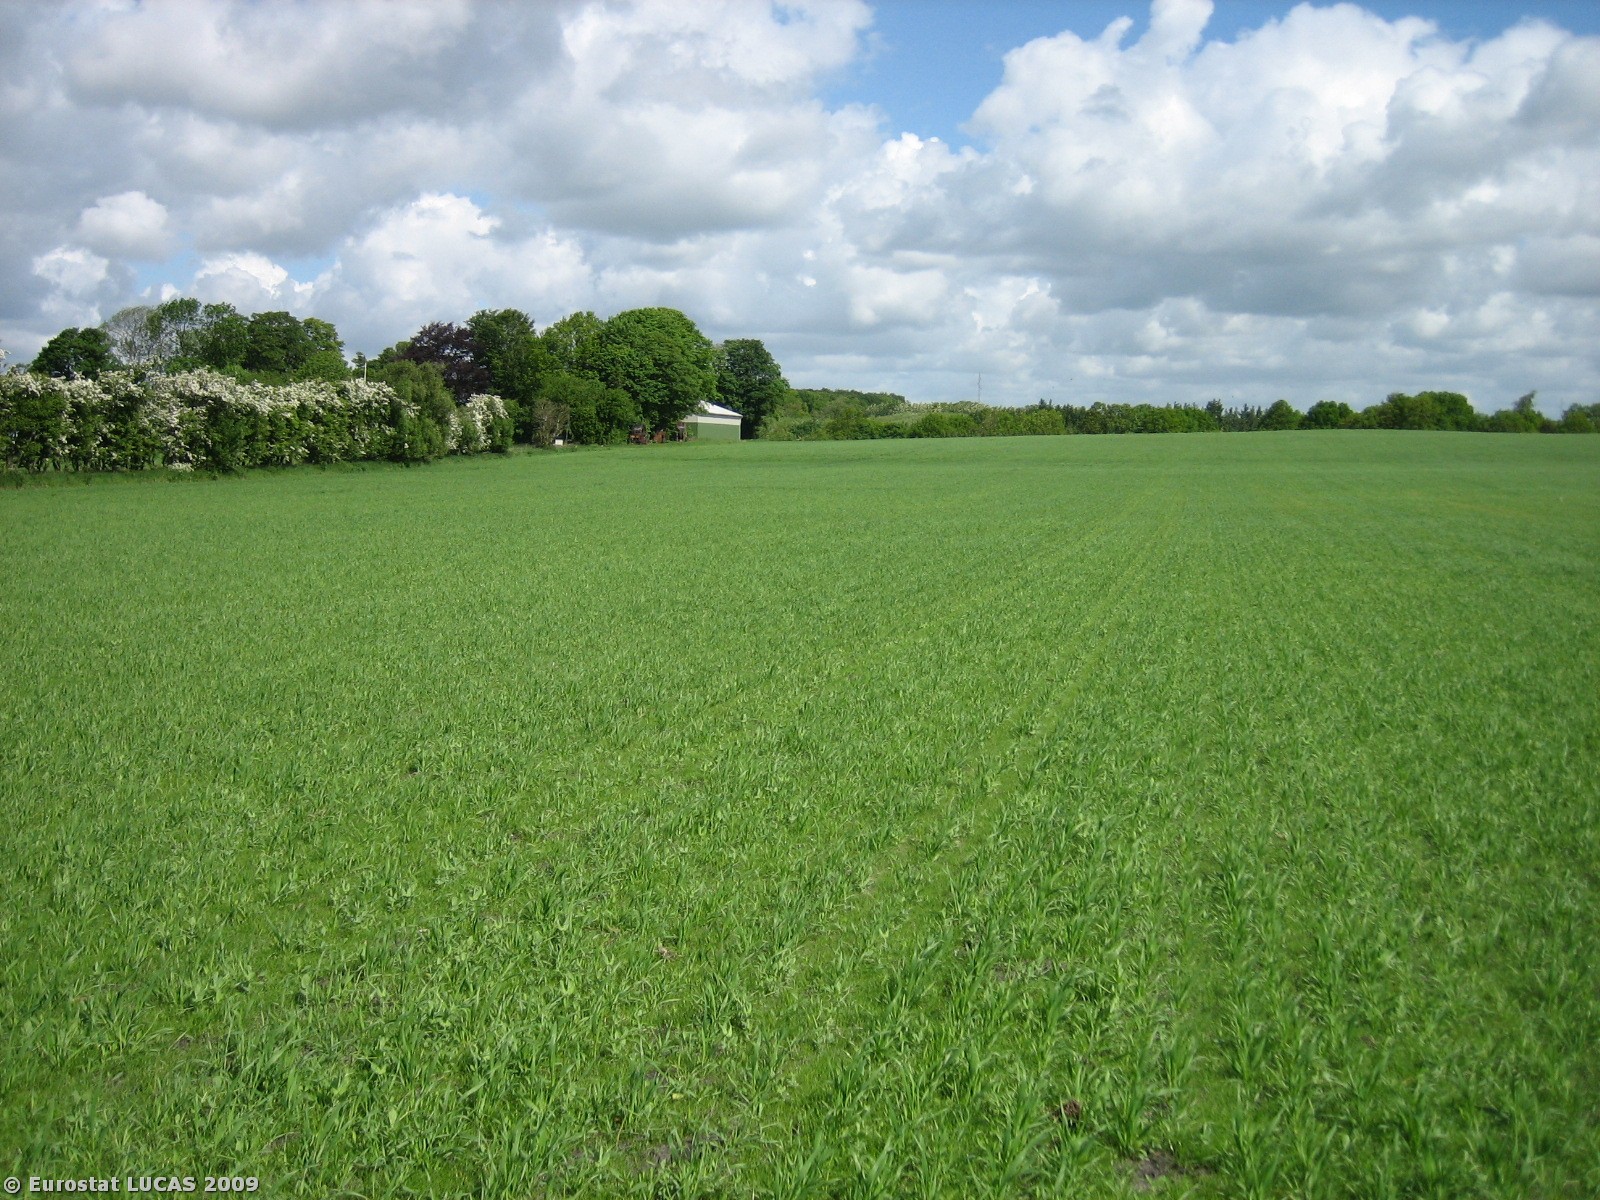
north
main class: Cropland
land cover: Rye
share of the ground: 25 - 50 %
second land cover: Dry pulses
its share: 10 - 25 %
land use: Agriculture (excluding fallow land and kitchen gardens)
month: May
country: DK
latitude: 55.8442
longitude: 9.2821
